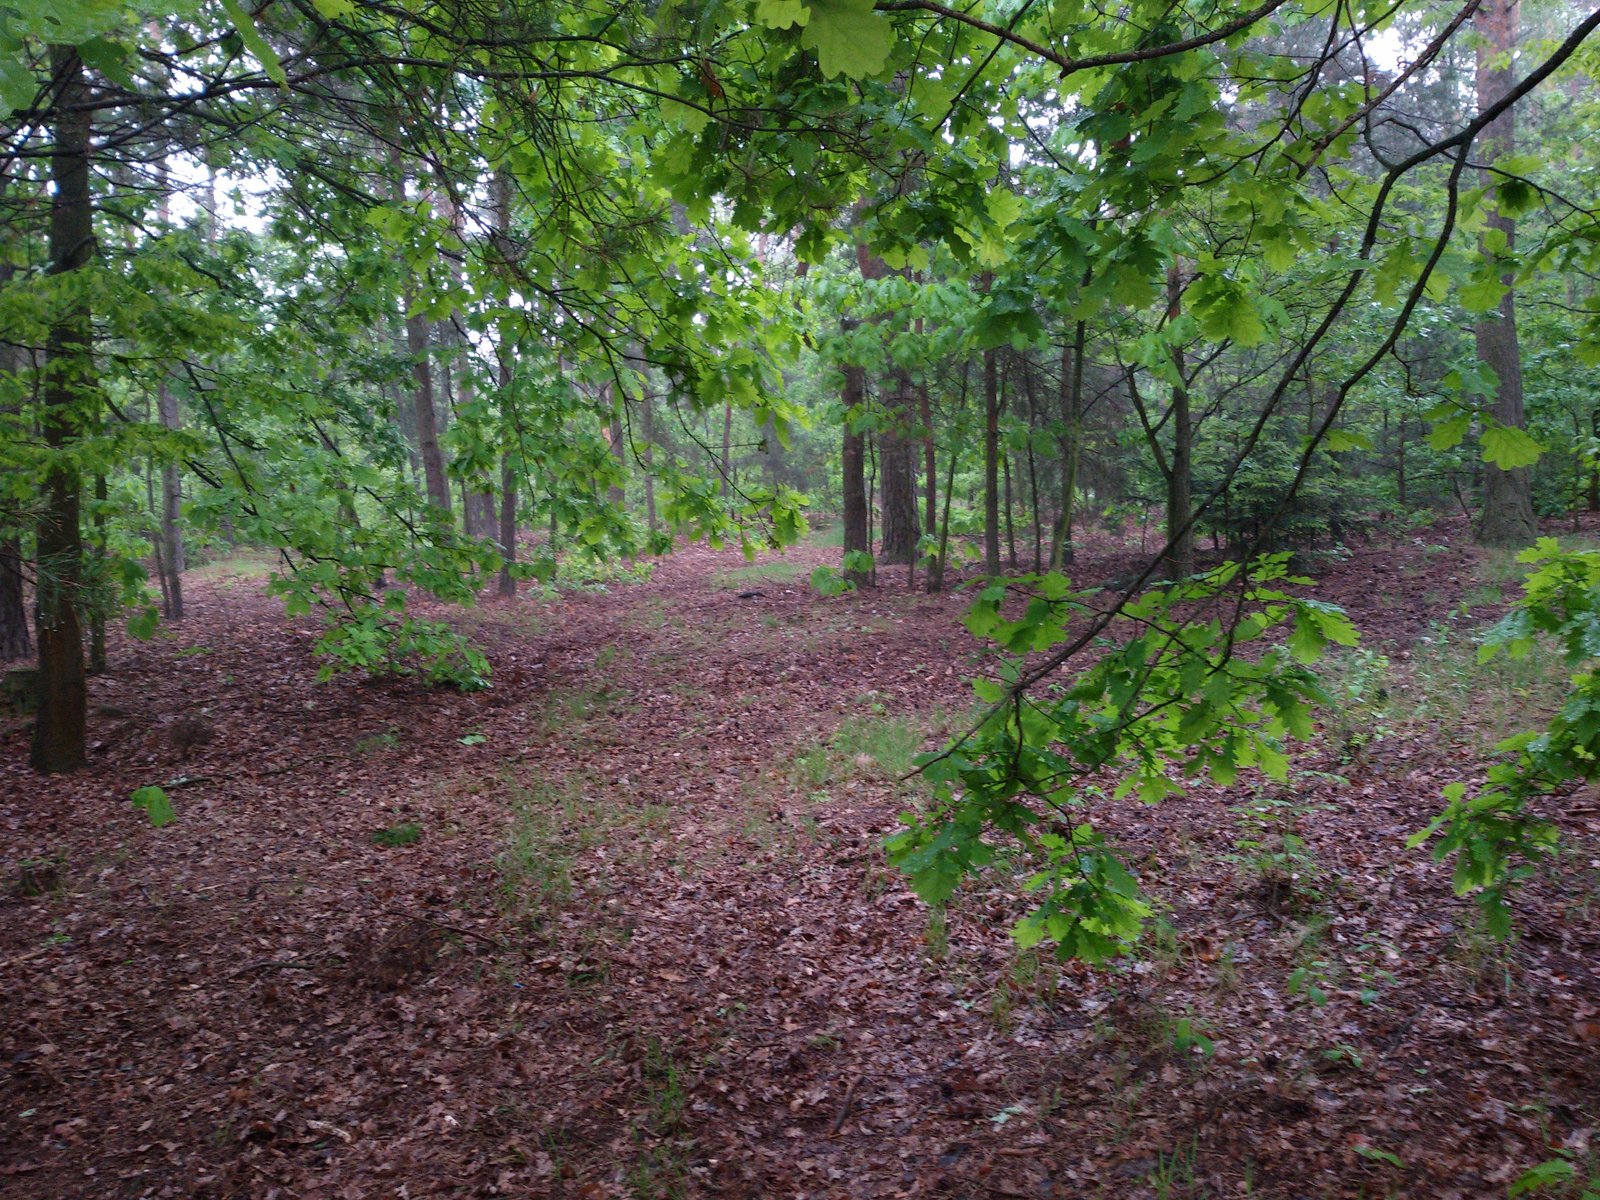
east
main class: Woodland
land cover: Pine dominated mixed woodland
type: hemiboreal forest and nemoral coniferous forest and mixed broadleaved-coniferous forest
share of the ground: > 75 %
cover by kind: coniferous forest trees 60 %, broadleaved forest trees 25 %, herbaceous plants 10 %, unconsolidated bare surface 5 %
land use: Forestry
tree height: > 5 m
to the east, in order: Pine dominated mixed woodland; Tracks; Pine dominated mixed woodland; Tracks; Artificial constructions in urban areas; Broadleaved woodland; Tracks; Broadleaved woodland
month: May
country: PL
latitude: 50.1458
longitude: 21.3127
